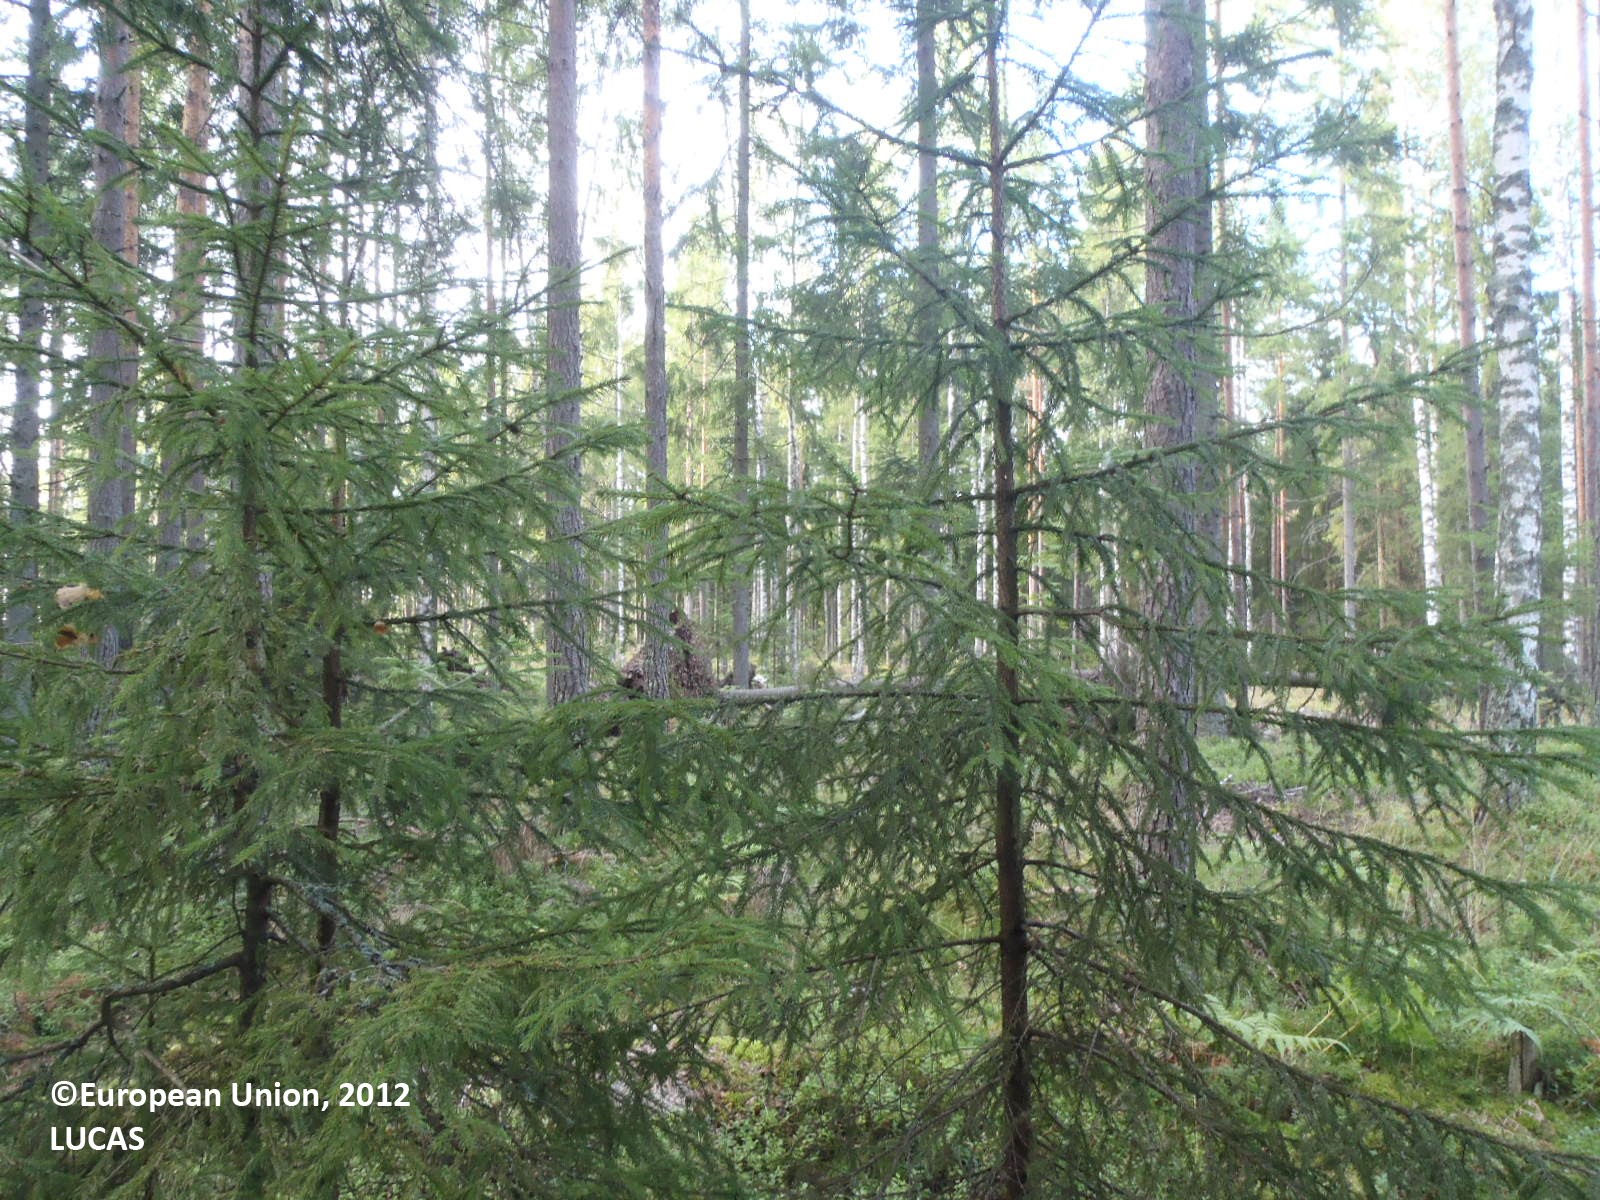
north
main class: Woodland
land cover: Pine dominated coniferous woodland
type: boreal forest
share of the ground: > 75 %
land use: Forestry
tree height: > 5 m
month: August
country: FI
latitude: 60.5738
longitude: 22.6812
